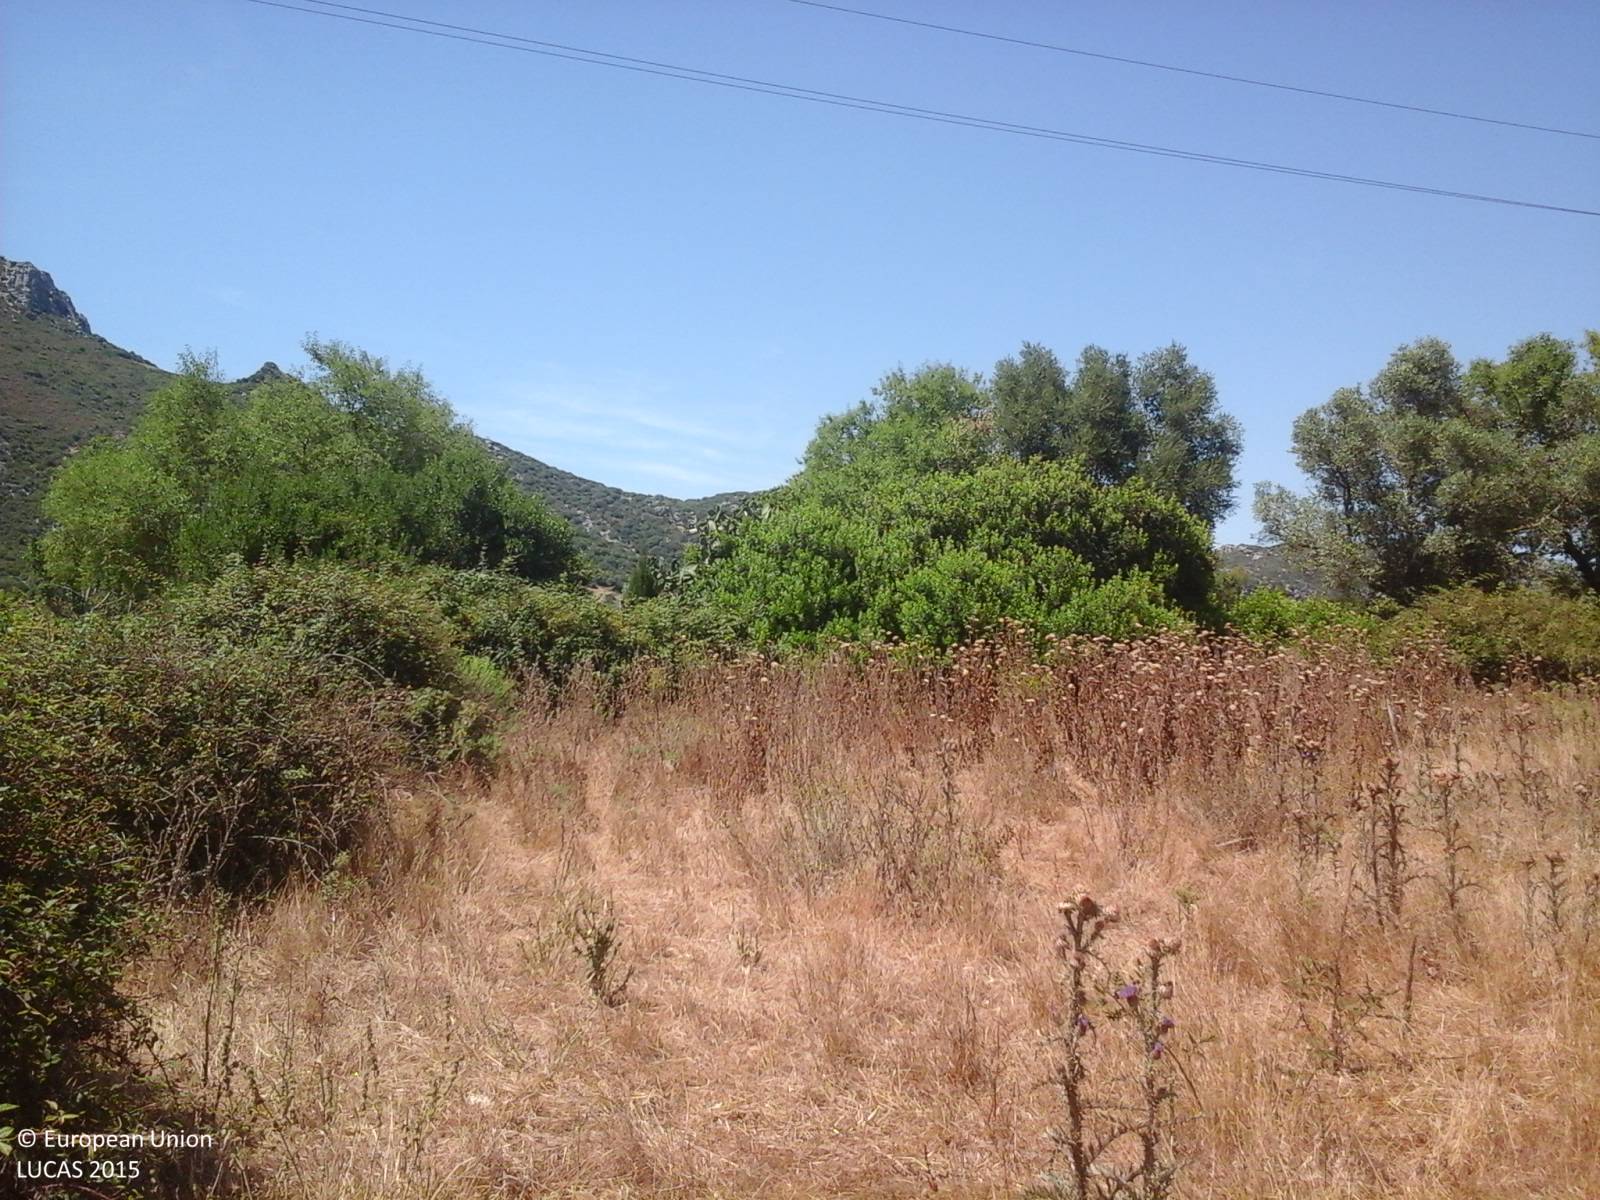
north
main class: Grassland
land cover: Grassland without tree/shrub cover
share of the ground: > 75 %
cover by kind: herbaceous plants 90 %, shrubs 5 %, unconsolidated bare surface 5 %
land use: Agriculture (excluding fallow land and kitchen gardens)
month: June
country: IT
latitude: 40.5564
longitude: 9.6827
